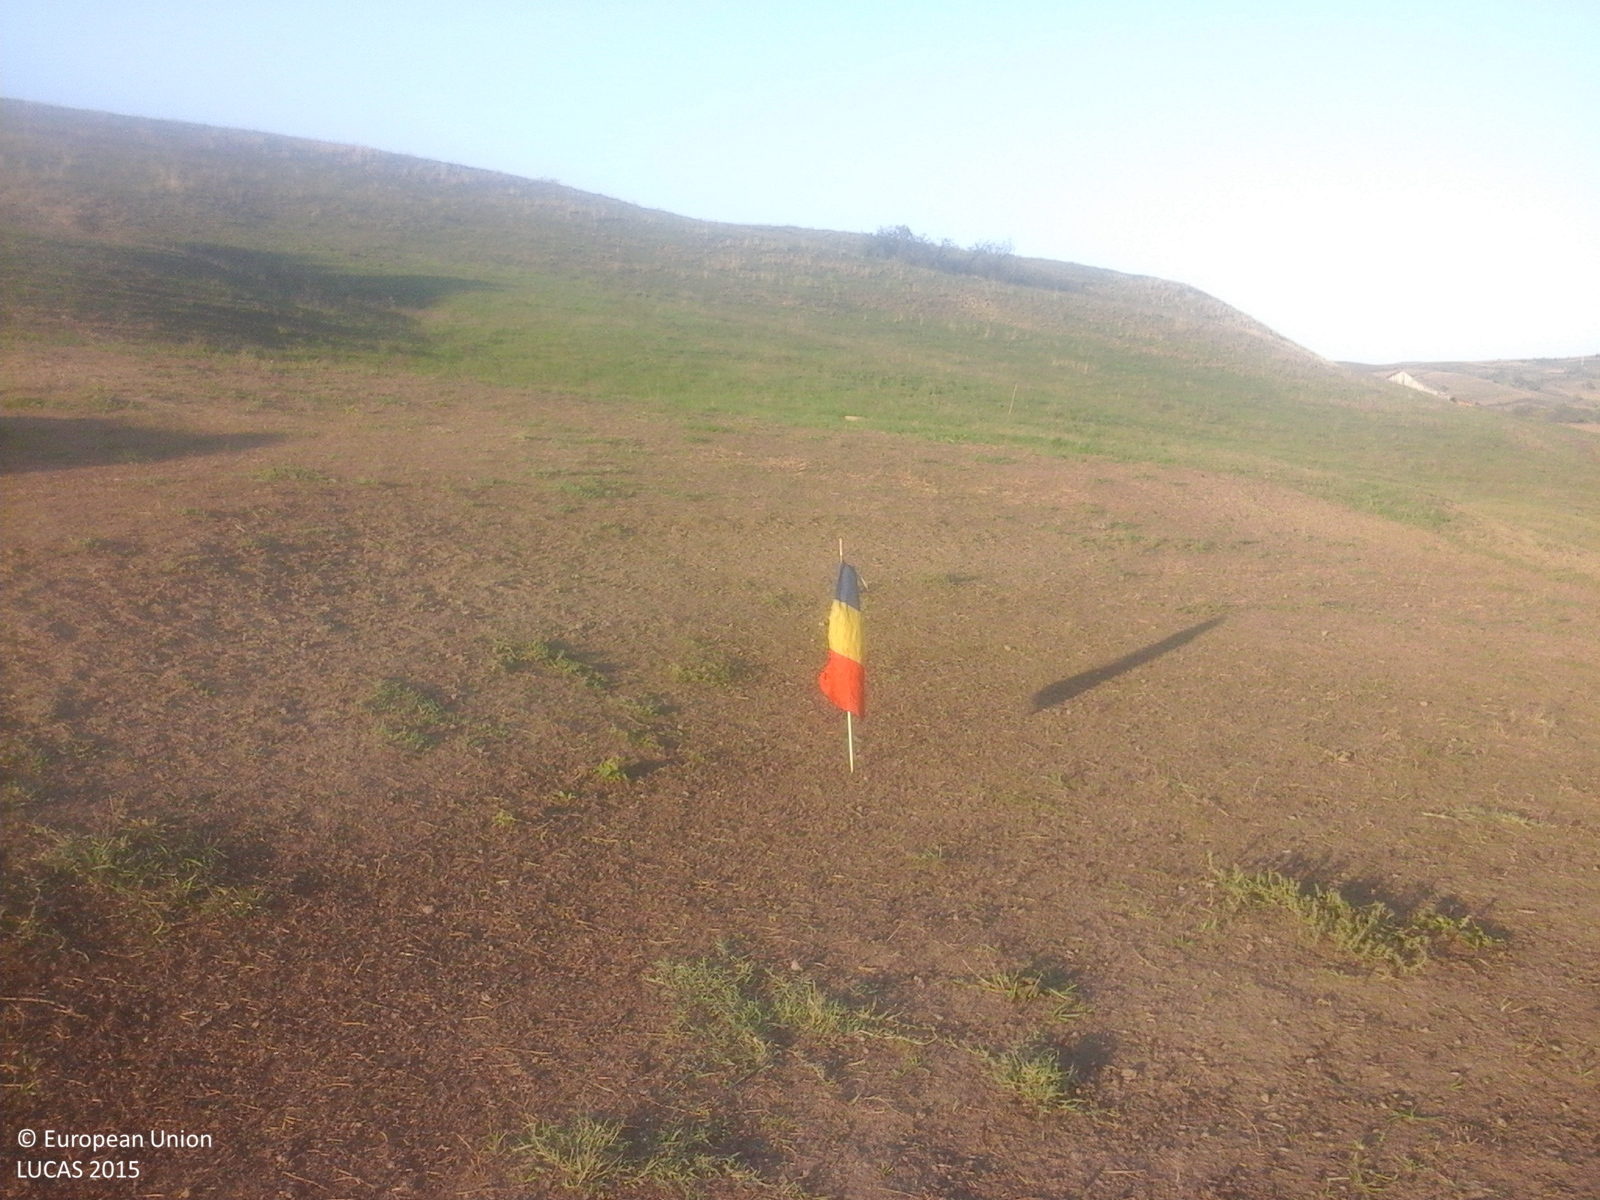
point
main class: Grassland
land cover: Grassland without tree/shrub cover
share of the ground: > 75 %
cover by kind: herbaceous plants 100 %
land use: Agriculture (excluding fallow land and kitchen gardens)
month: October
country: RO
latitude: 45.9243
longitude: 24.0914
